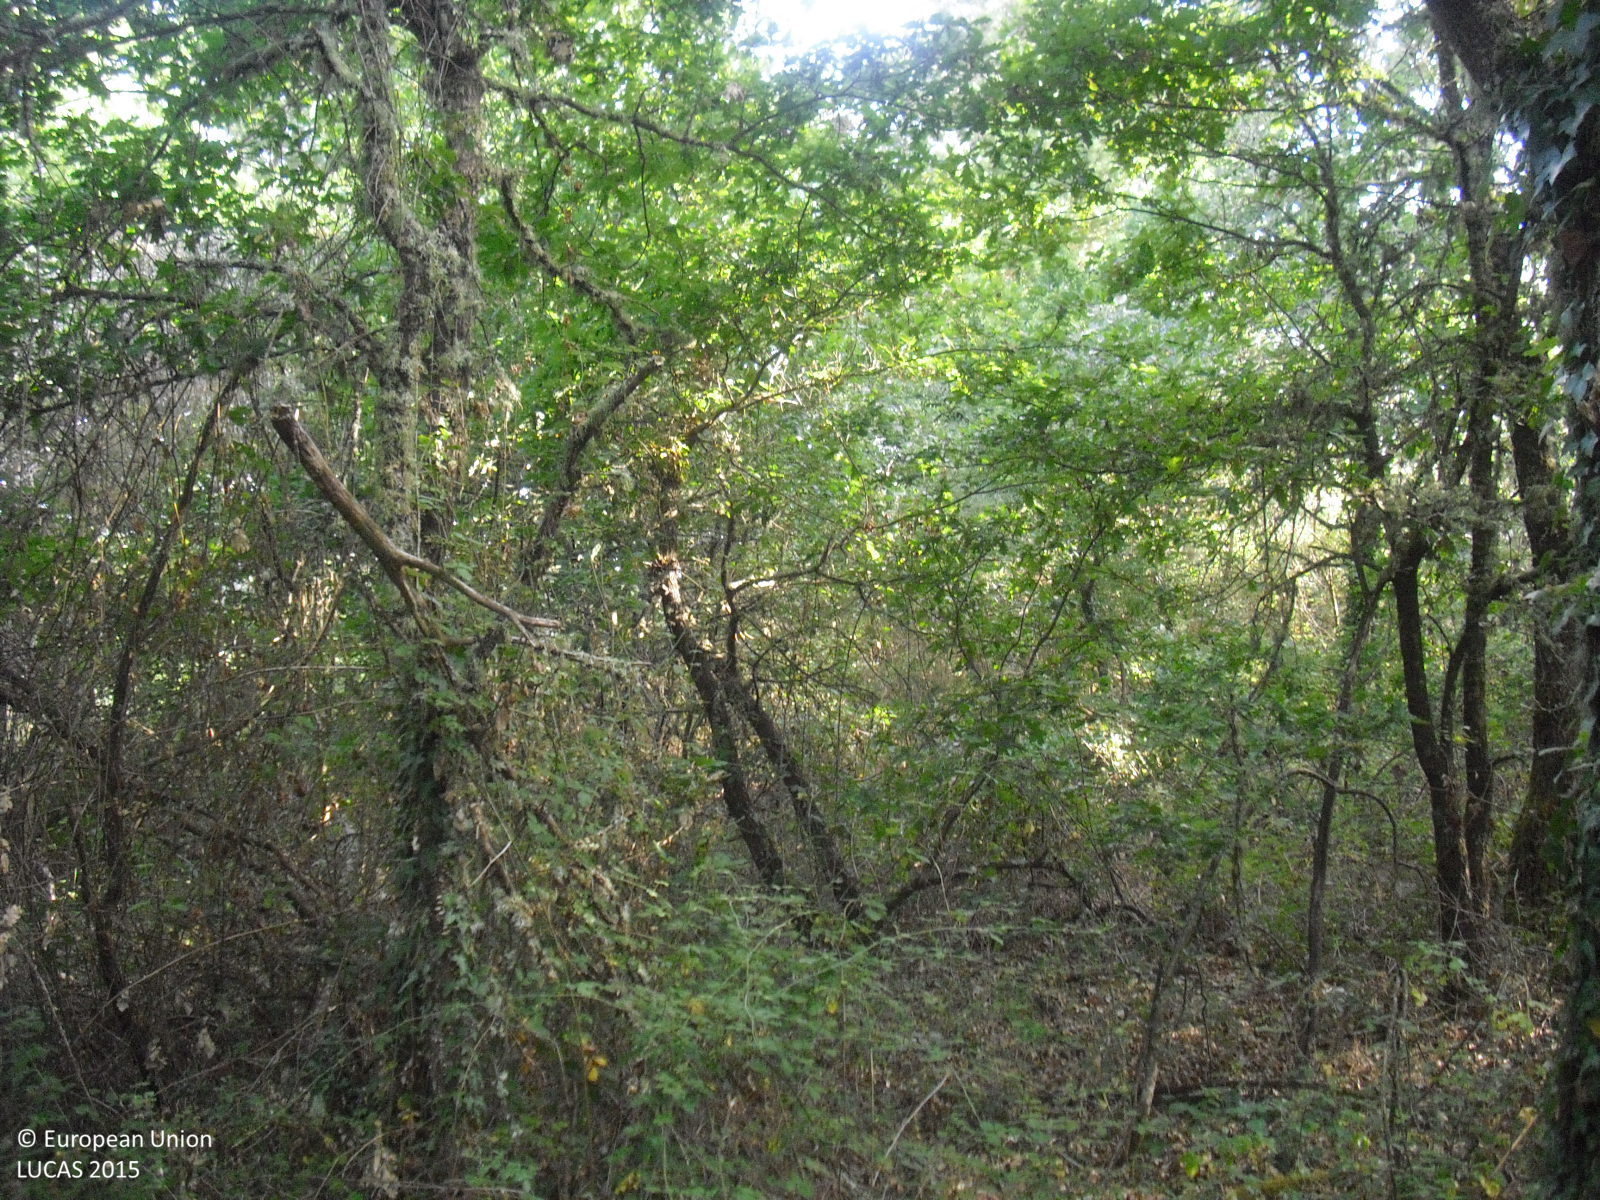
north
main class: Woodland
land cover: Broadleaved woodland
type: thermophilous deciduous forest
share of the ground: > 75 %
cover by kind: broadleaved forest trees 80 %, shrubs 20 %
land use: Semi-natural and natural areas not in use
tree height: > 5 m
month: July
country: ES
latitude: 42.5763
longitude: -7.4796
